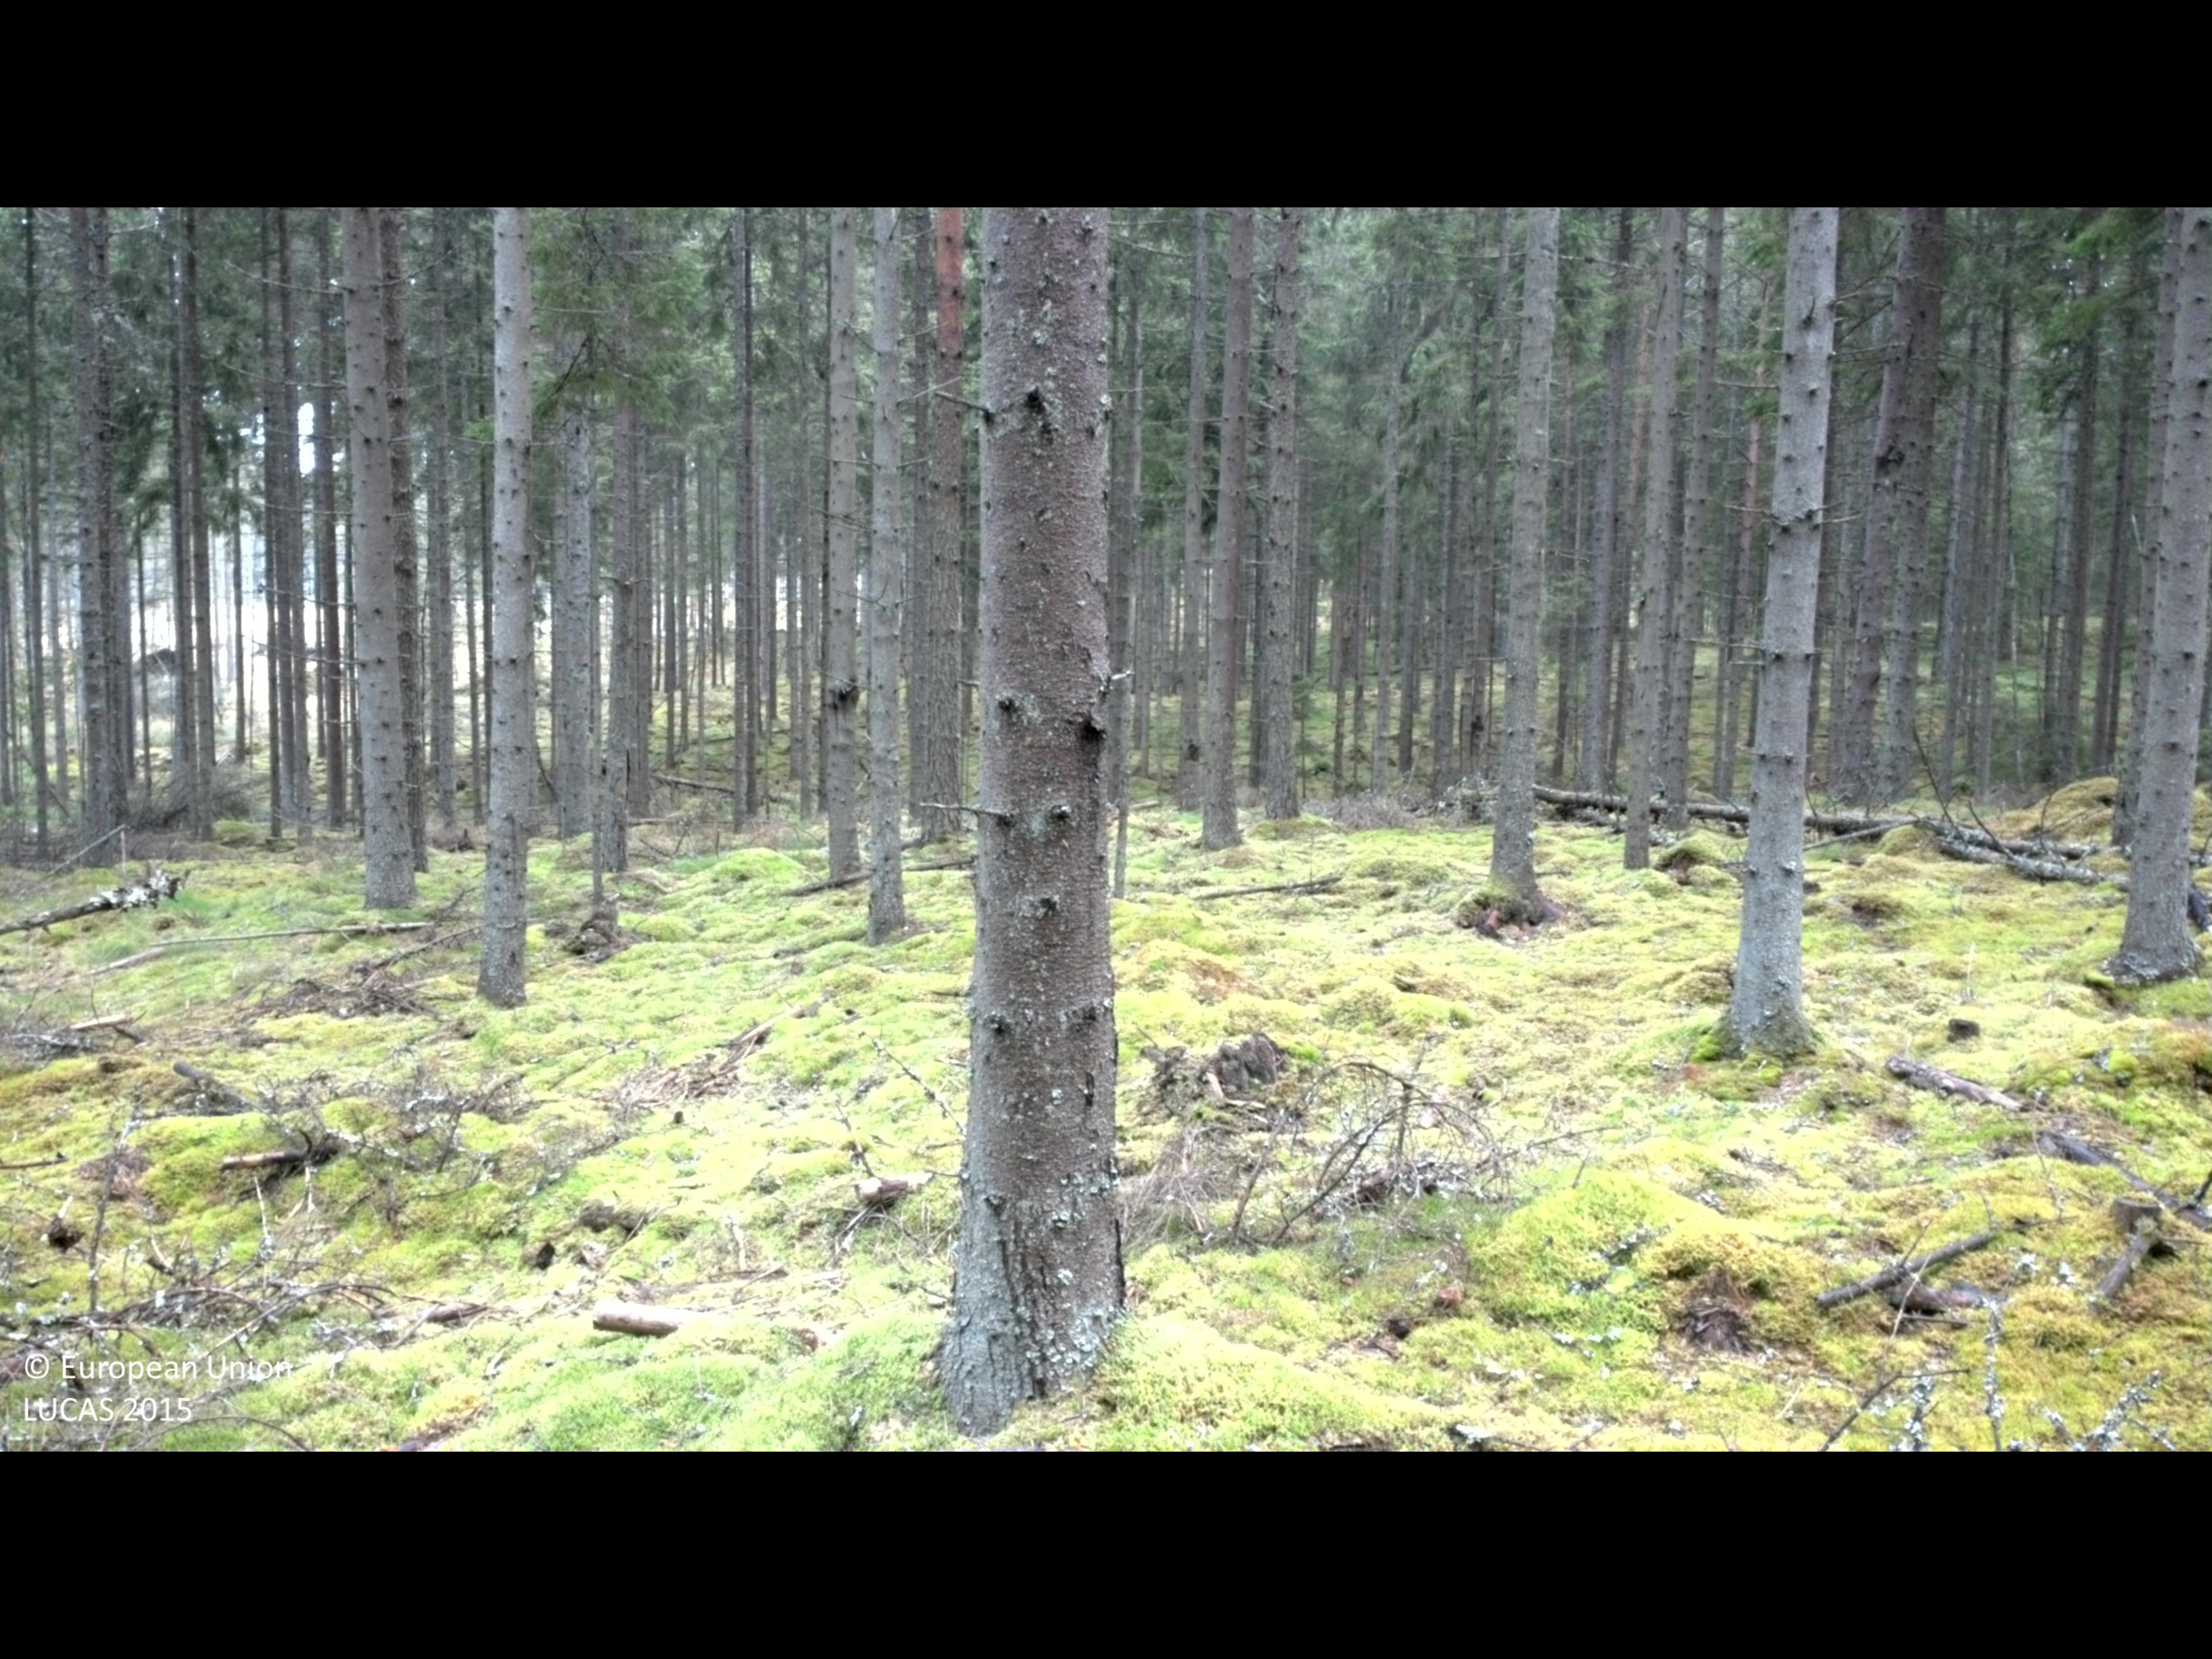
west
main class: Woodland
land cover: Spruce dominated coniferous woodland
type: boreal forest
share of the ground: 50 - 75 %
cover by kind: coniferous forest trees 75 %, lichens and mosses 25 %
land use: Forestry
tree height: > 5 m
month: August
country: SE
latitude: 57.3007
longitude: 13.8297
